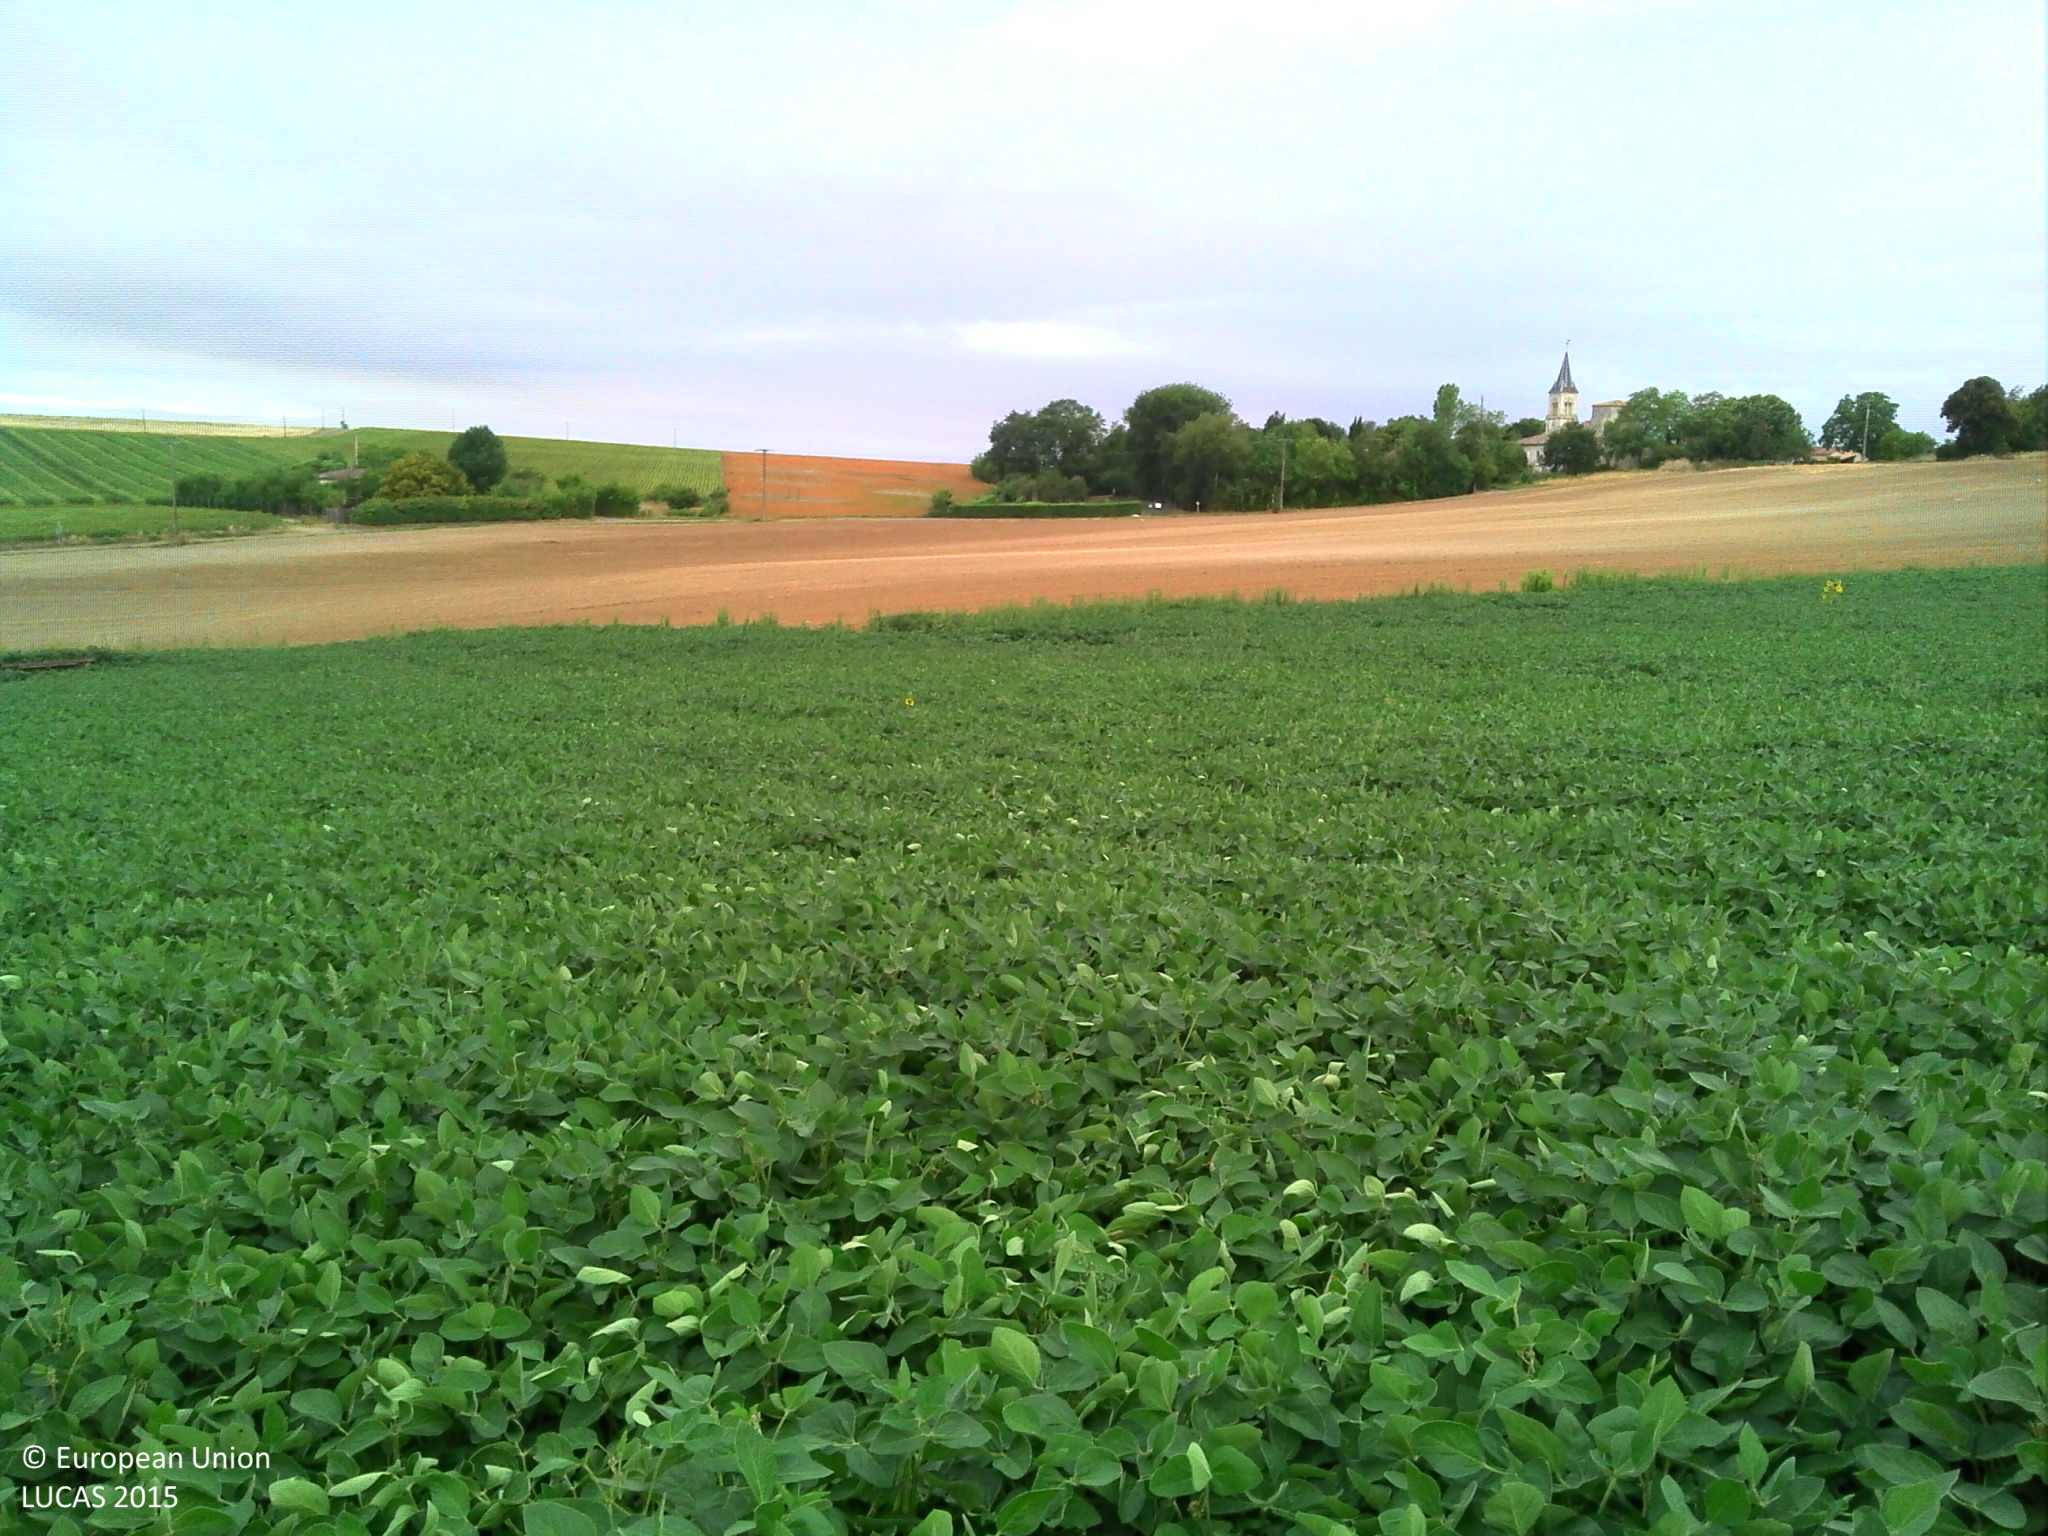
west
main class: Cropland
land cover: Soya
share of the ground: > 75 %
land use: Agriculture (excluding fallow land and kitchen gardens)
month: July
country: FR
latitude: 44.2576
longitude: 0.8902
